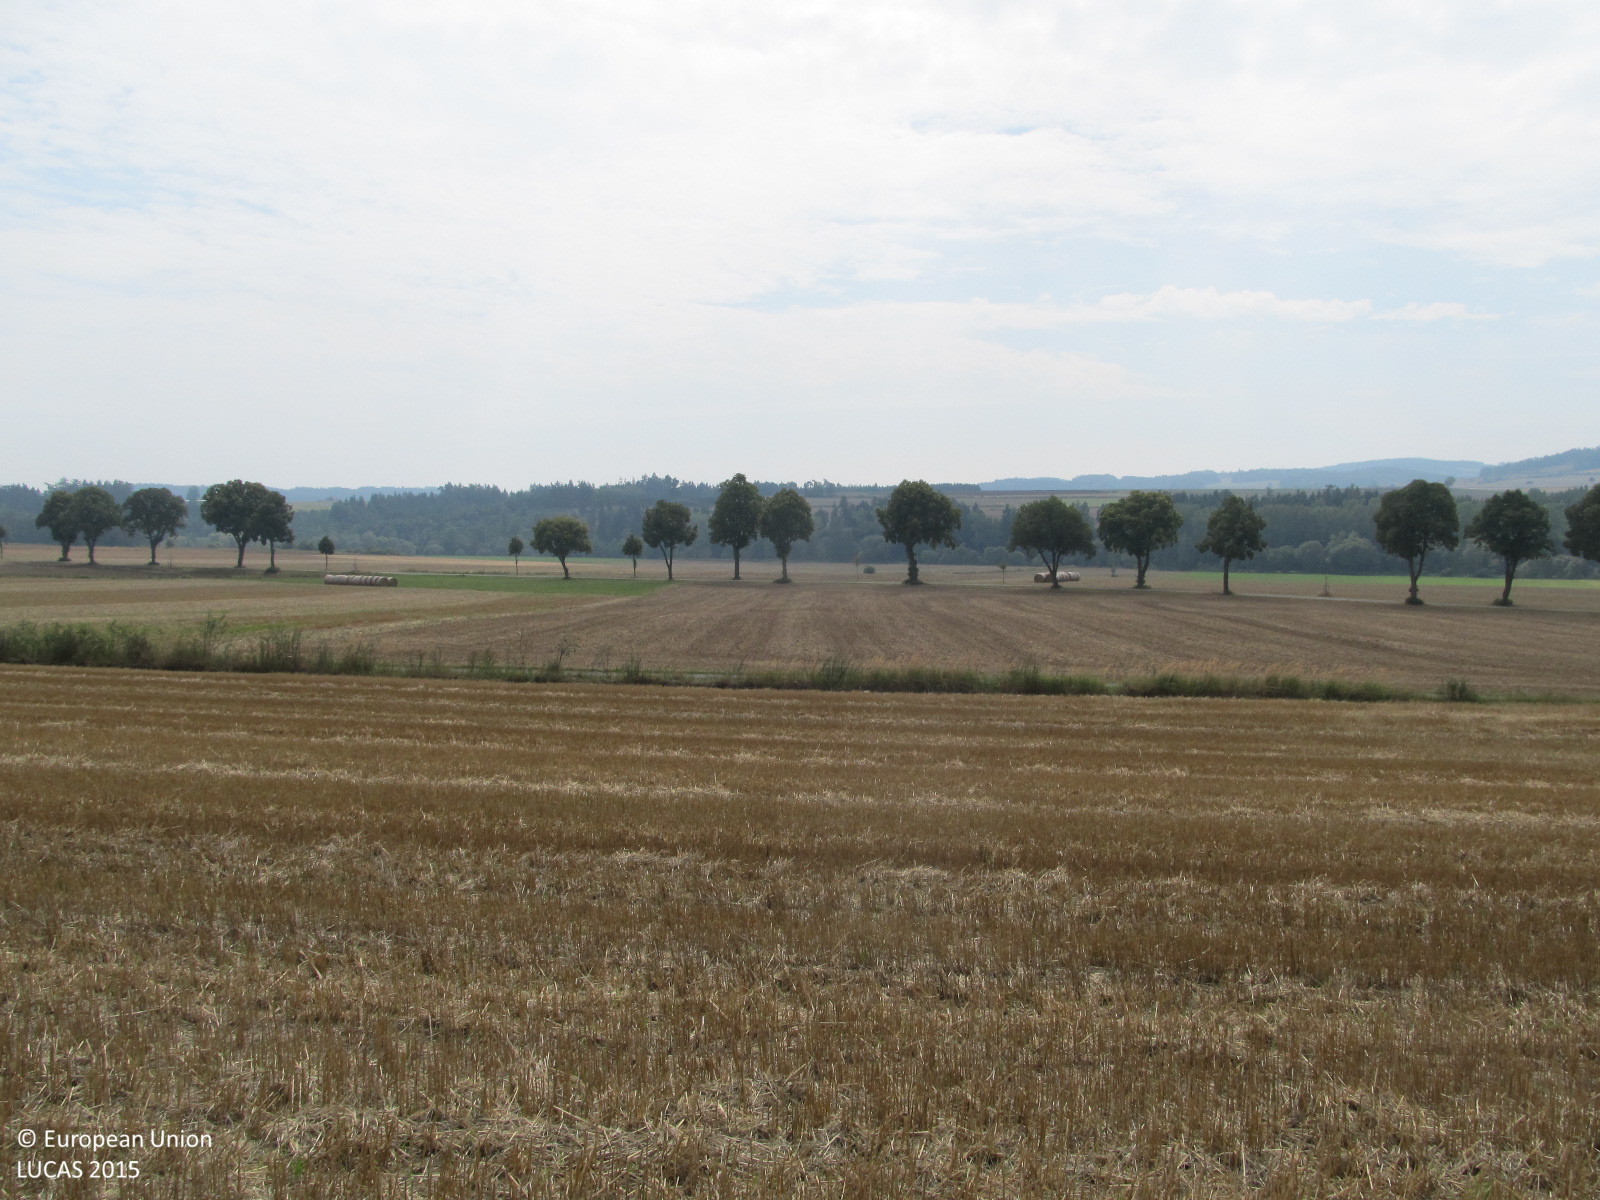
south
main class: Cropland
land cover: Common wheat
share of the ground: 25 - 50 %
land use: Agriculture (excluding fallow land and kitchen gardens)
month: August
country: AT
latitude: 48.8646
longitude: 15.4422
